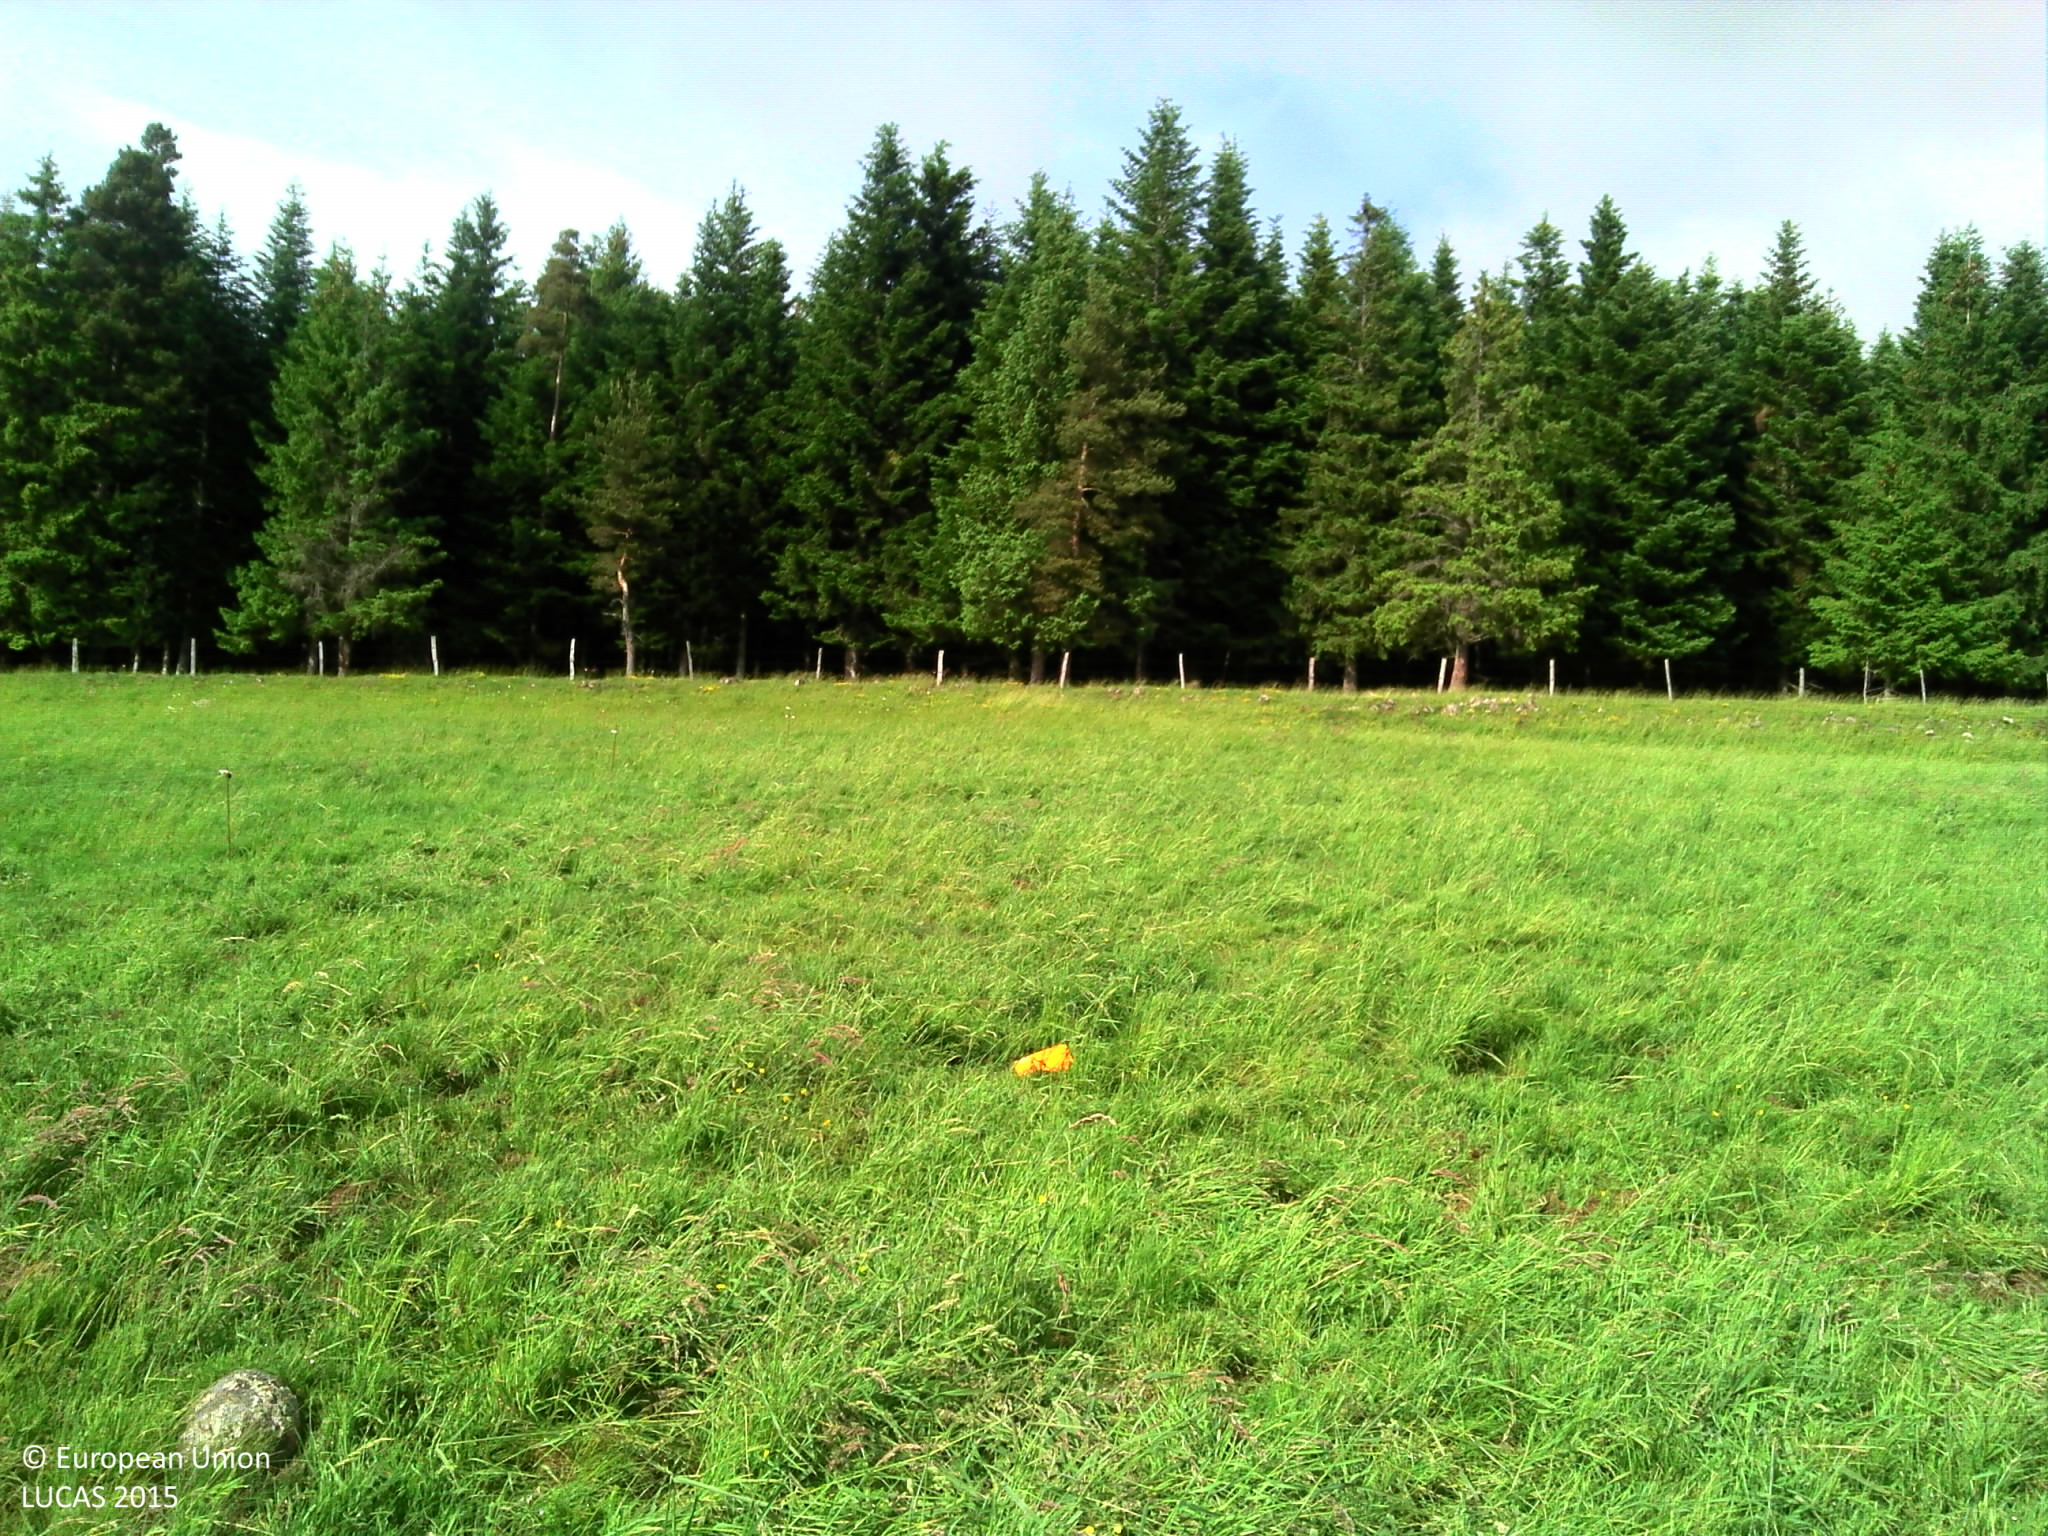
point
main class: Grassland
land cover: Grassland without tree/shrub cover
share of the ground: > 75 %
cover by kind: herbaceous plants 100 %
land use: Agriculture (excluding fallow land and kitchen gardens)
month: June
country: FR
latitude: 45.2295
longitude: 2.9066
